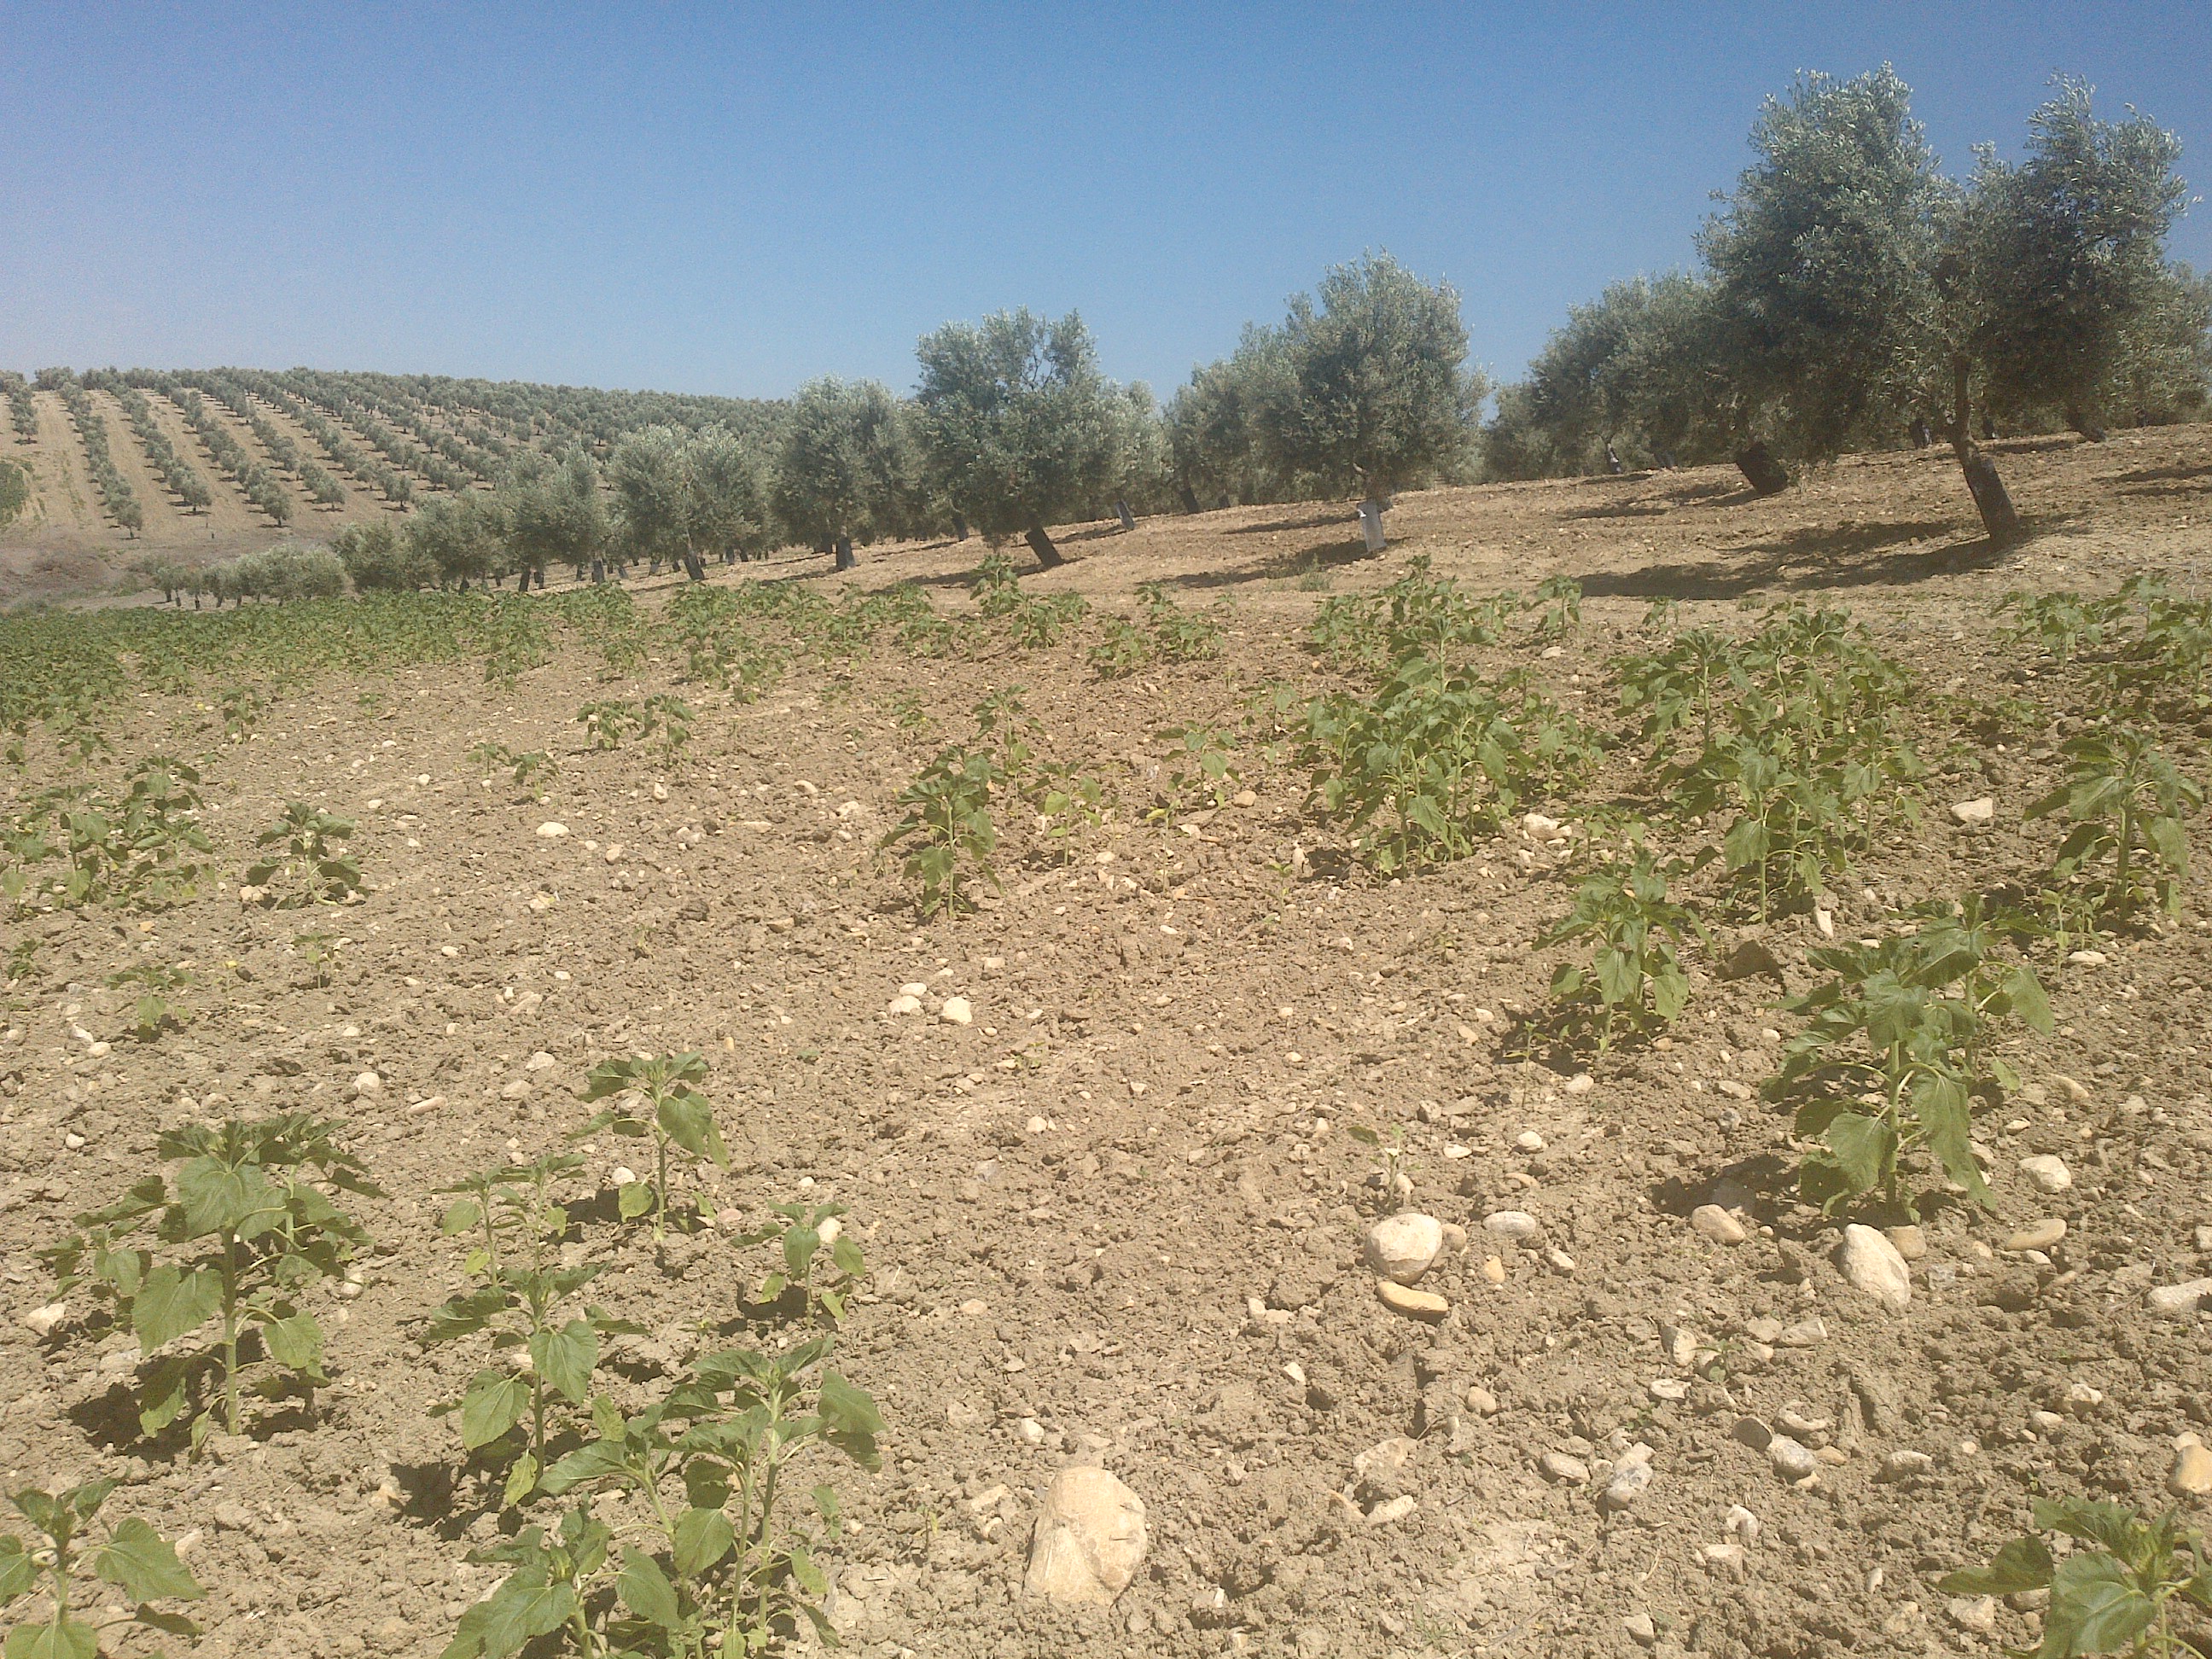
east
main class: Cropland
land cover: Sunflower
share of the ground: > 75 %
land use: Agriculture (excluding fallow land and kitchen gardens)
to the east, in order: Sunflower
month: May
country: ES
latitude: 37.7482
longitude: -4.6394
